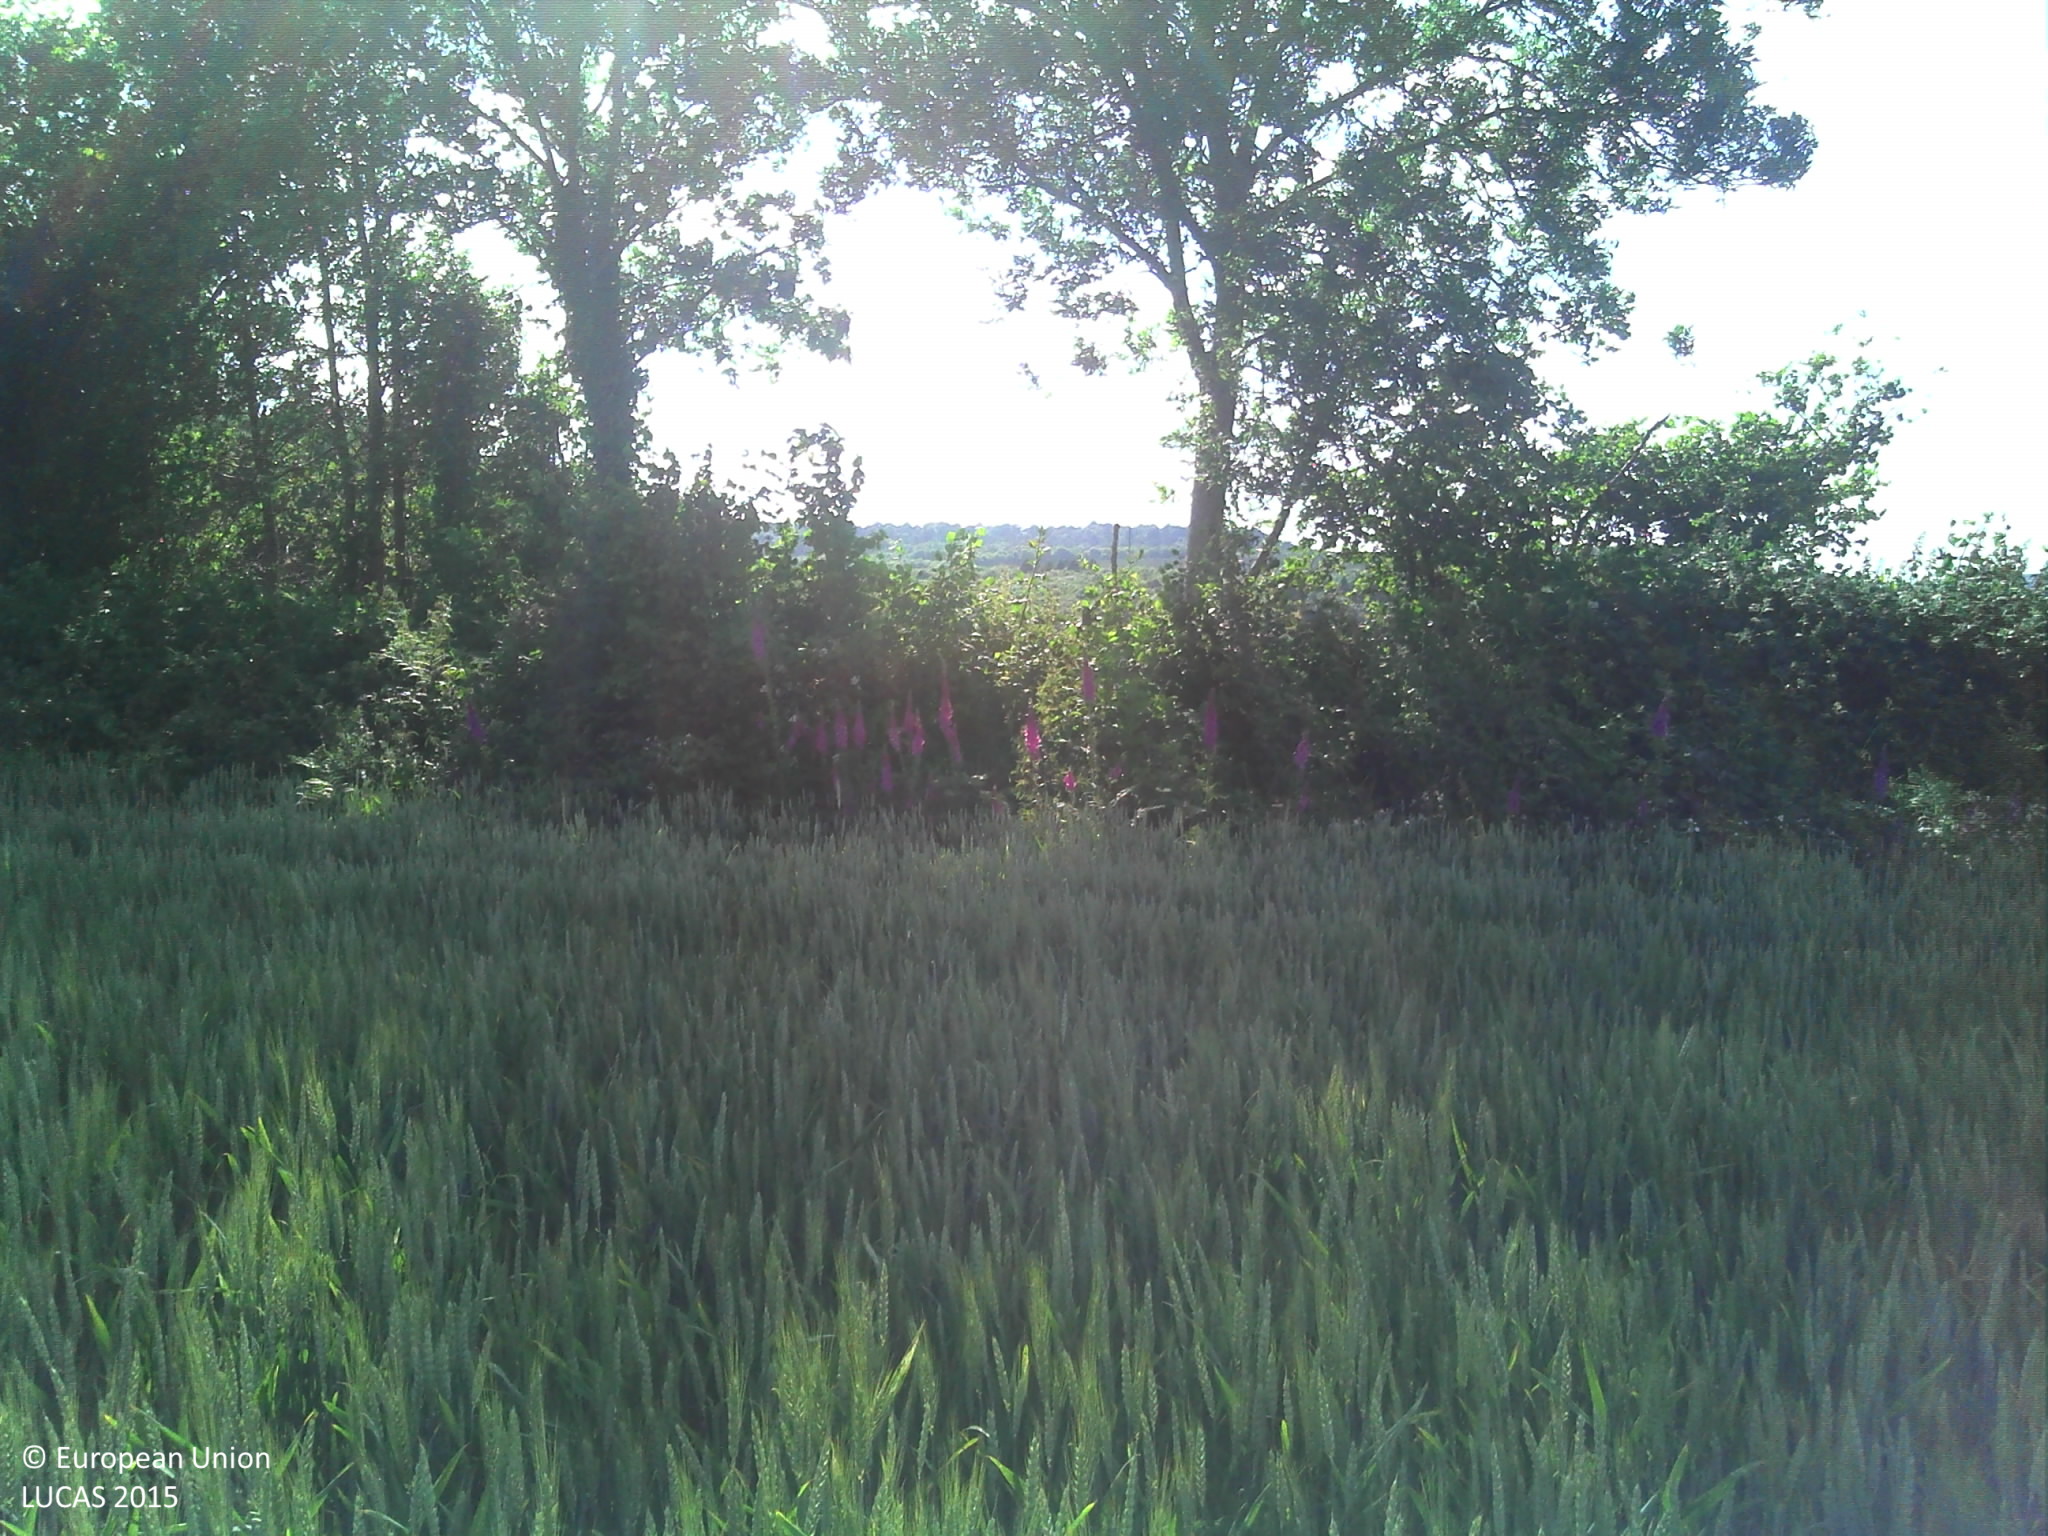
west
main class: Cropland
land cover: Common wheat
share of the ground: > 75 %
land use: Agriculture (excluding fallow land and kitchen gardens)
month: June
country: FR
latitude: 48.4626
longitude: -0.1331
